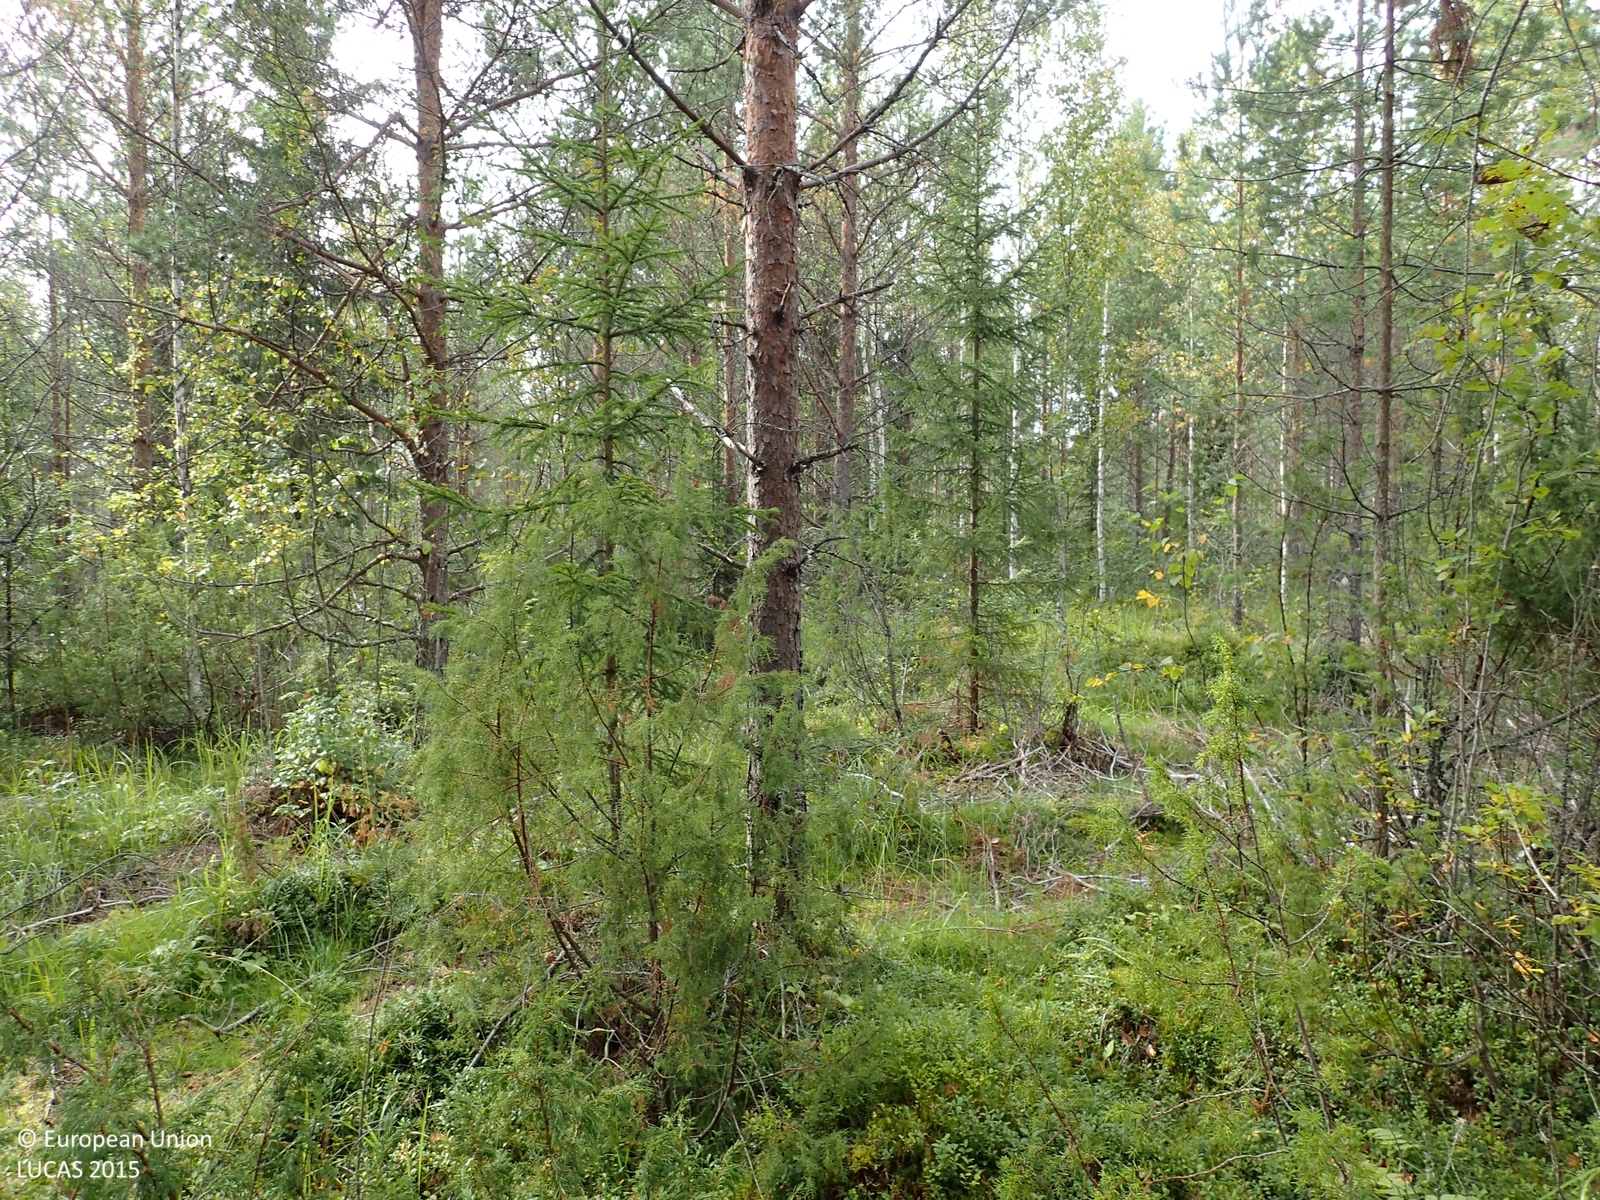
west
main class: Woodland
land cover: Pine dominated mixed woodland
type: boreal forest
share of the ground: > 75 %
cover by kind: coniferous forest trees 55 %, shrubs 25 %, broadleaved forest trees 20 %
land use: Forestry
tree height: > 5 m
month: September
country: FI
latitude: 63.0824
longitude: 26.1395
